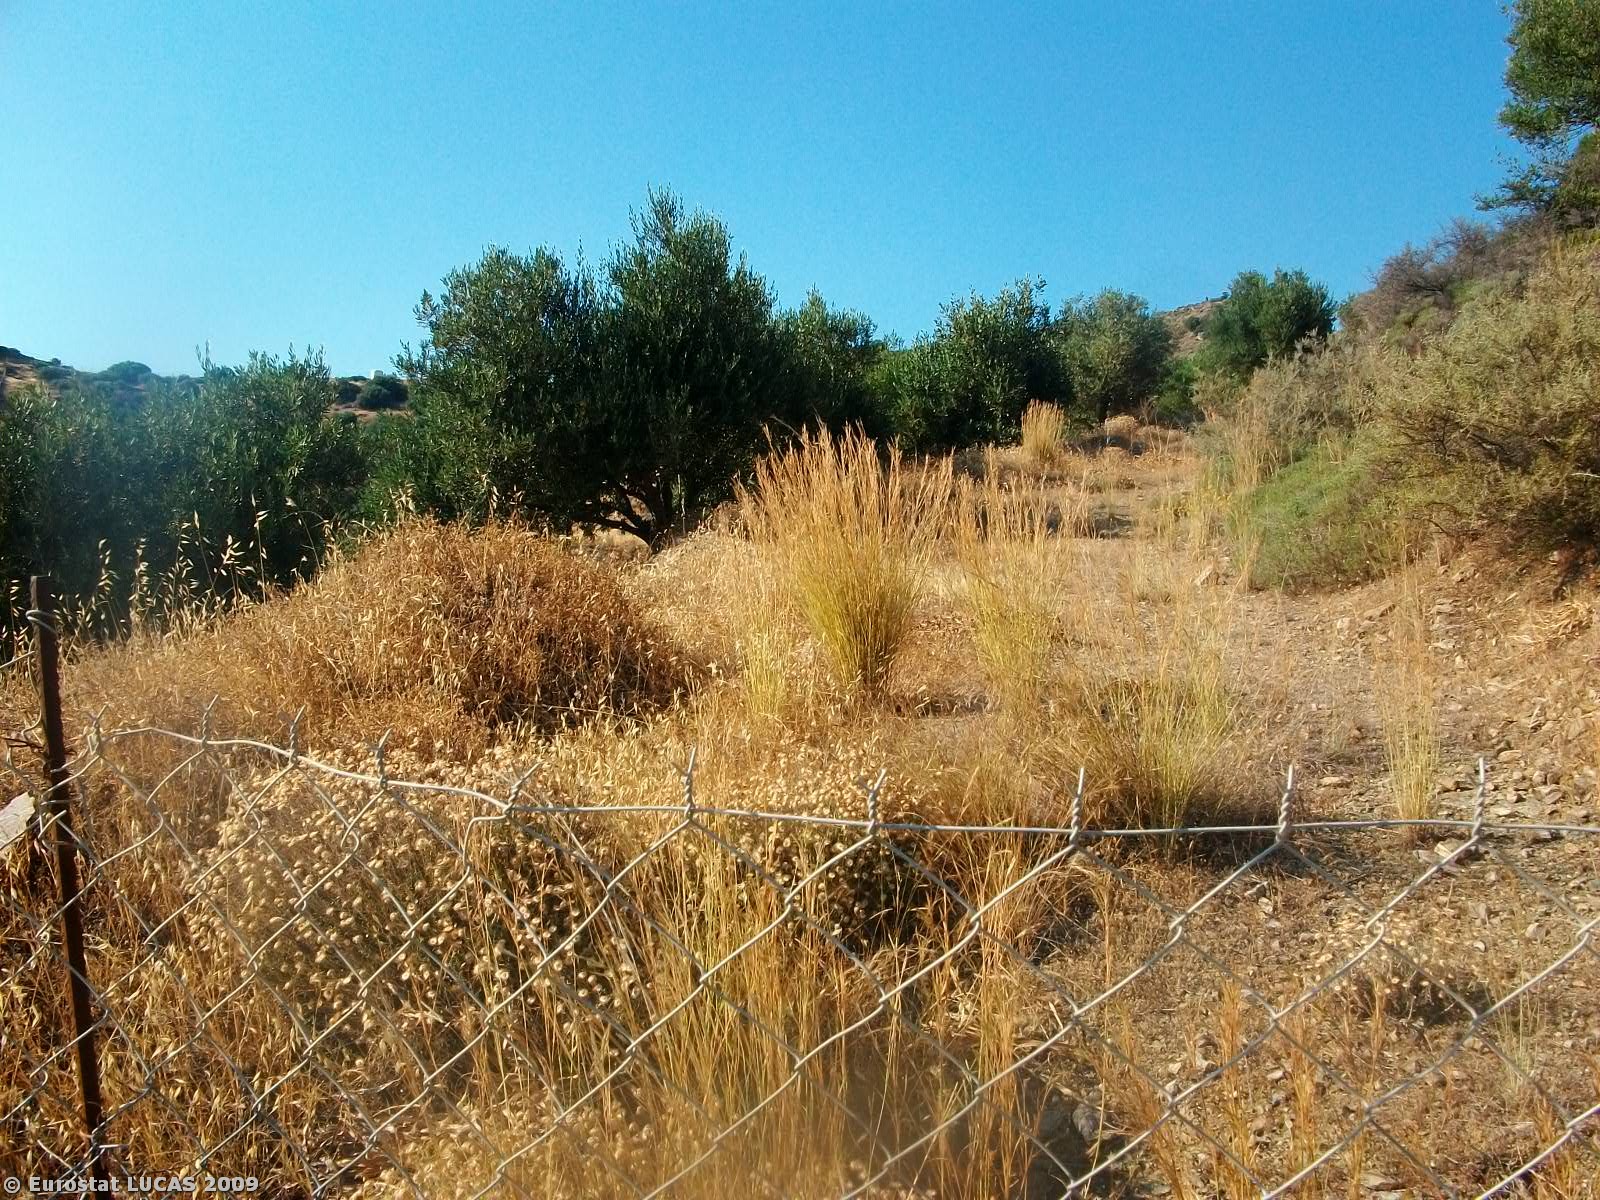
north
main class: Shrubland
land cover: Shrubland with sparse tree cover
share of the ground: > 75 %
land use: Unused
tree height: < 5 m
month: June
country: GR
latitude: 34.9580
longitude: 24.8211
